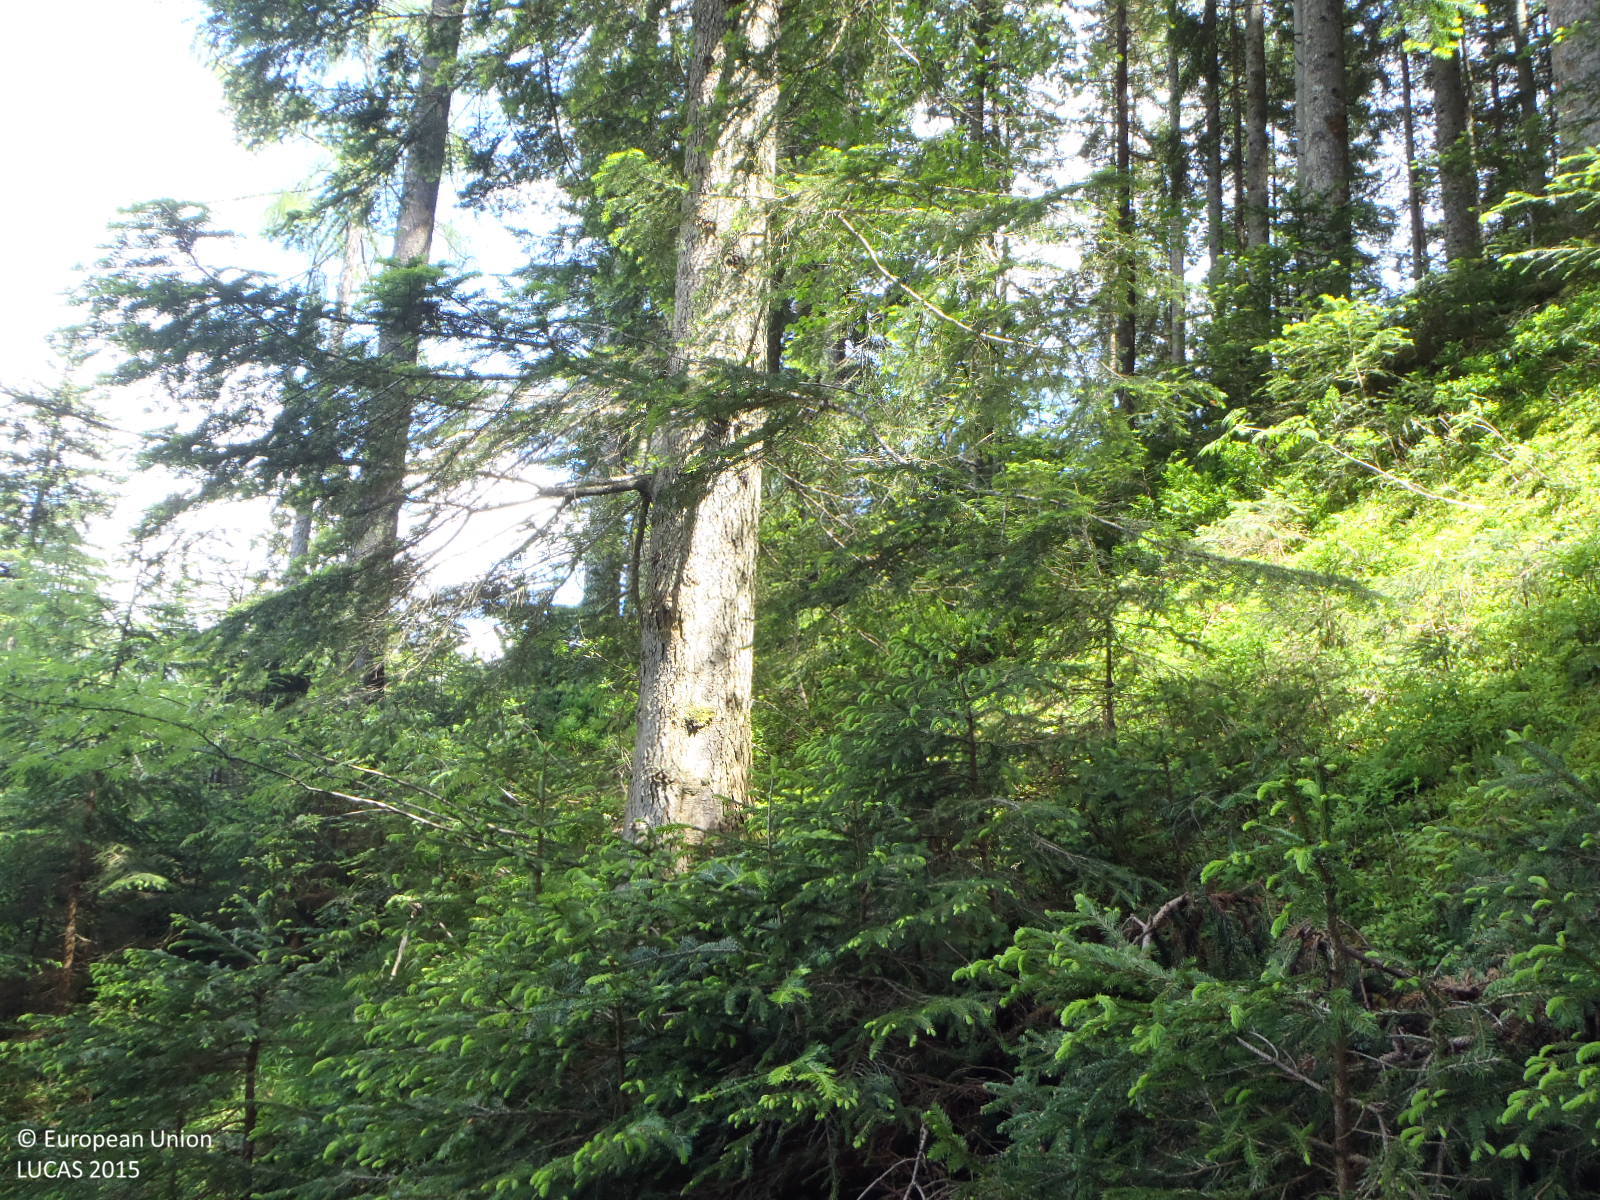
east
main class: Woodland
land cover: Other coniferous woodland
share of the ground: > 75 %
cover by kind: coniferous forest trees 75 %, broadleaved forest trees 10 %, shrubs 10 %, herbaceous plants 5 %
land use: Forestry
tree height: > 5 m
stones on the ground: < 10 %
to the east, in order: Other coniferous woodland; Rivers and streams; Tracks; Other coniferous woodland; Rivers and streams; Other coniferous woodland; Rivers and streams; Other coniferous woodland; Rivers and streams; Other coniferous woodland
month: June
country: AT
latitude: 47.4537
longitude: 12.6377
